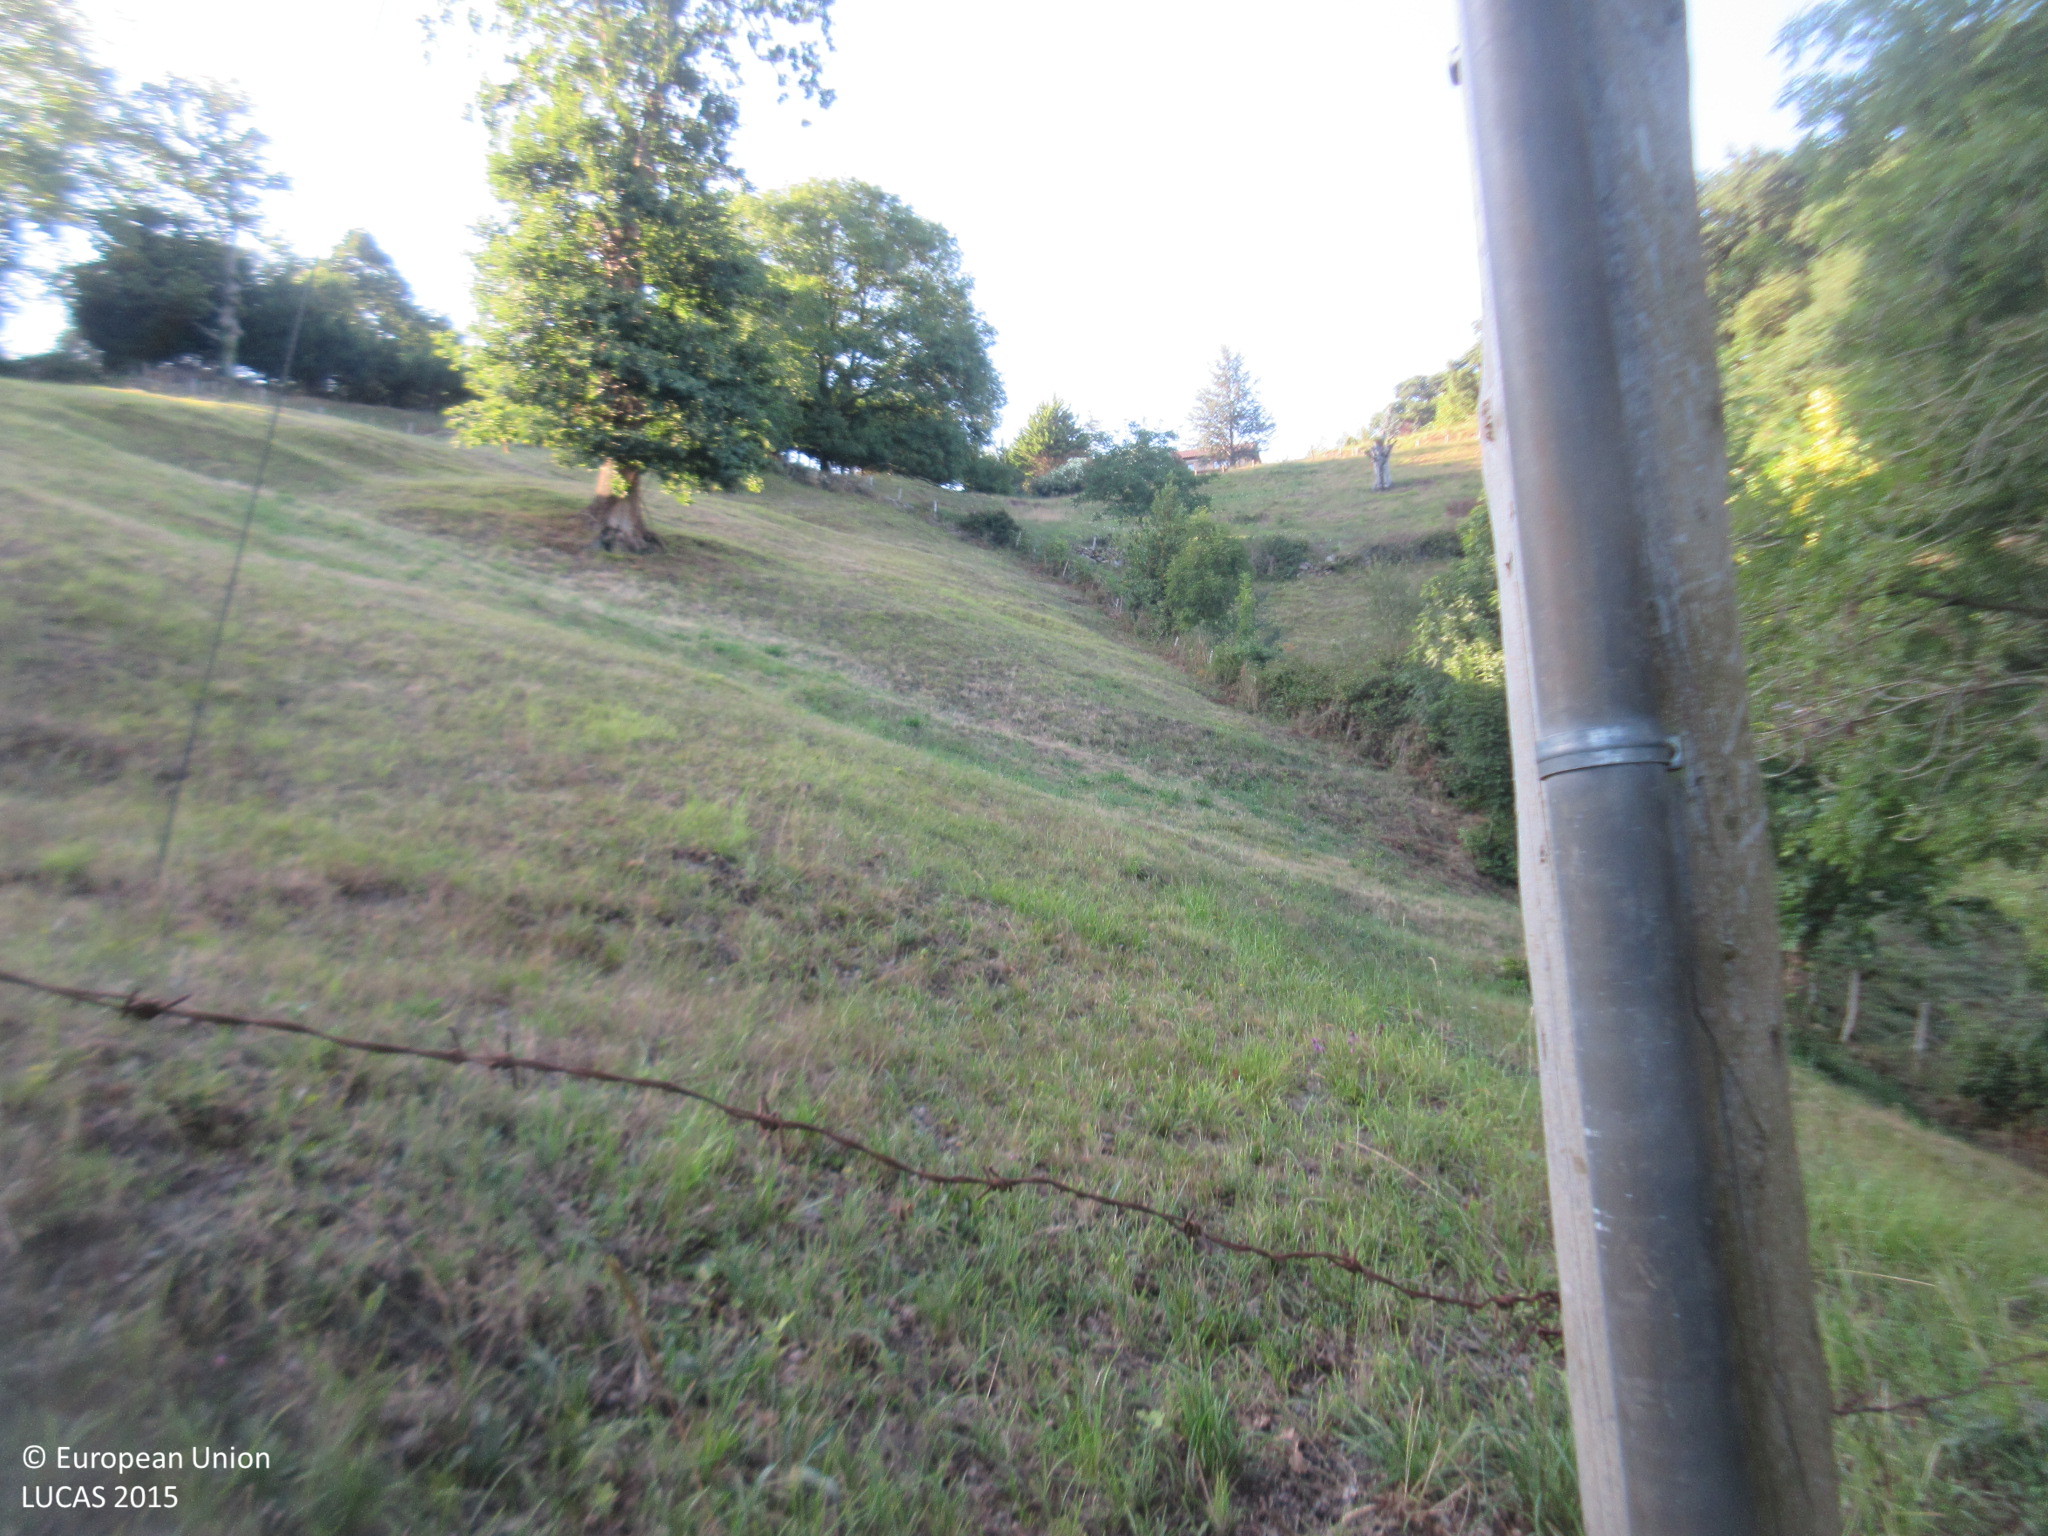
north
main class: Grassland
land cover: Grassland without tree/shrub cover
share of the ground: > 75 %
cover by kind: herbaceous plants 100 %
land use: Agriculture (excluding fallow land and kitchen gardens)
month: July
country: ES
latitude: 43.2380
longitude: -3.9523
